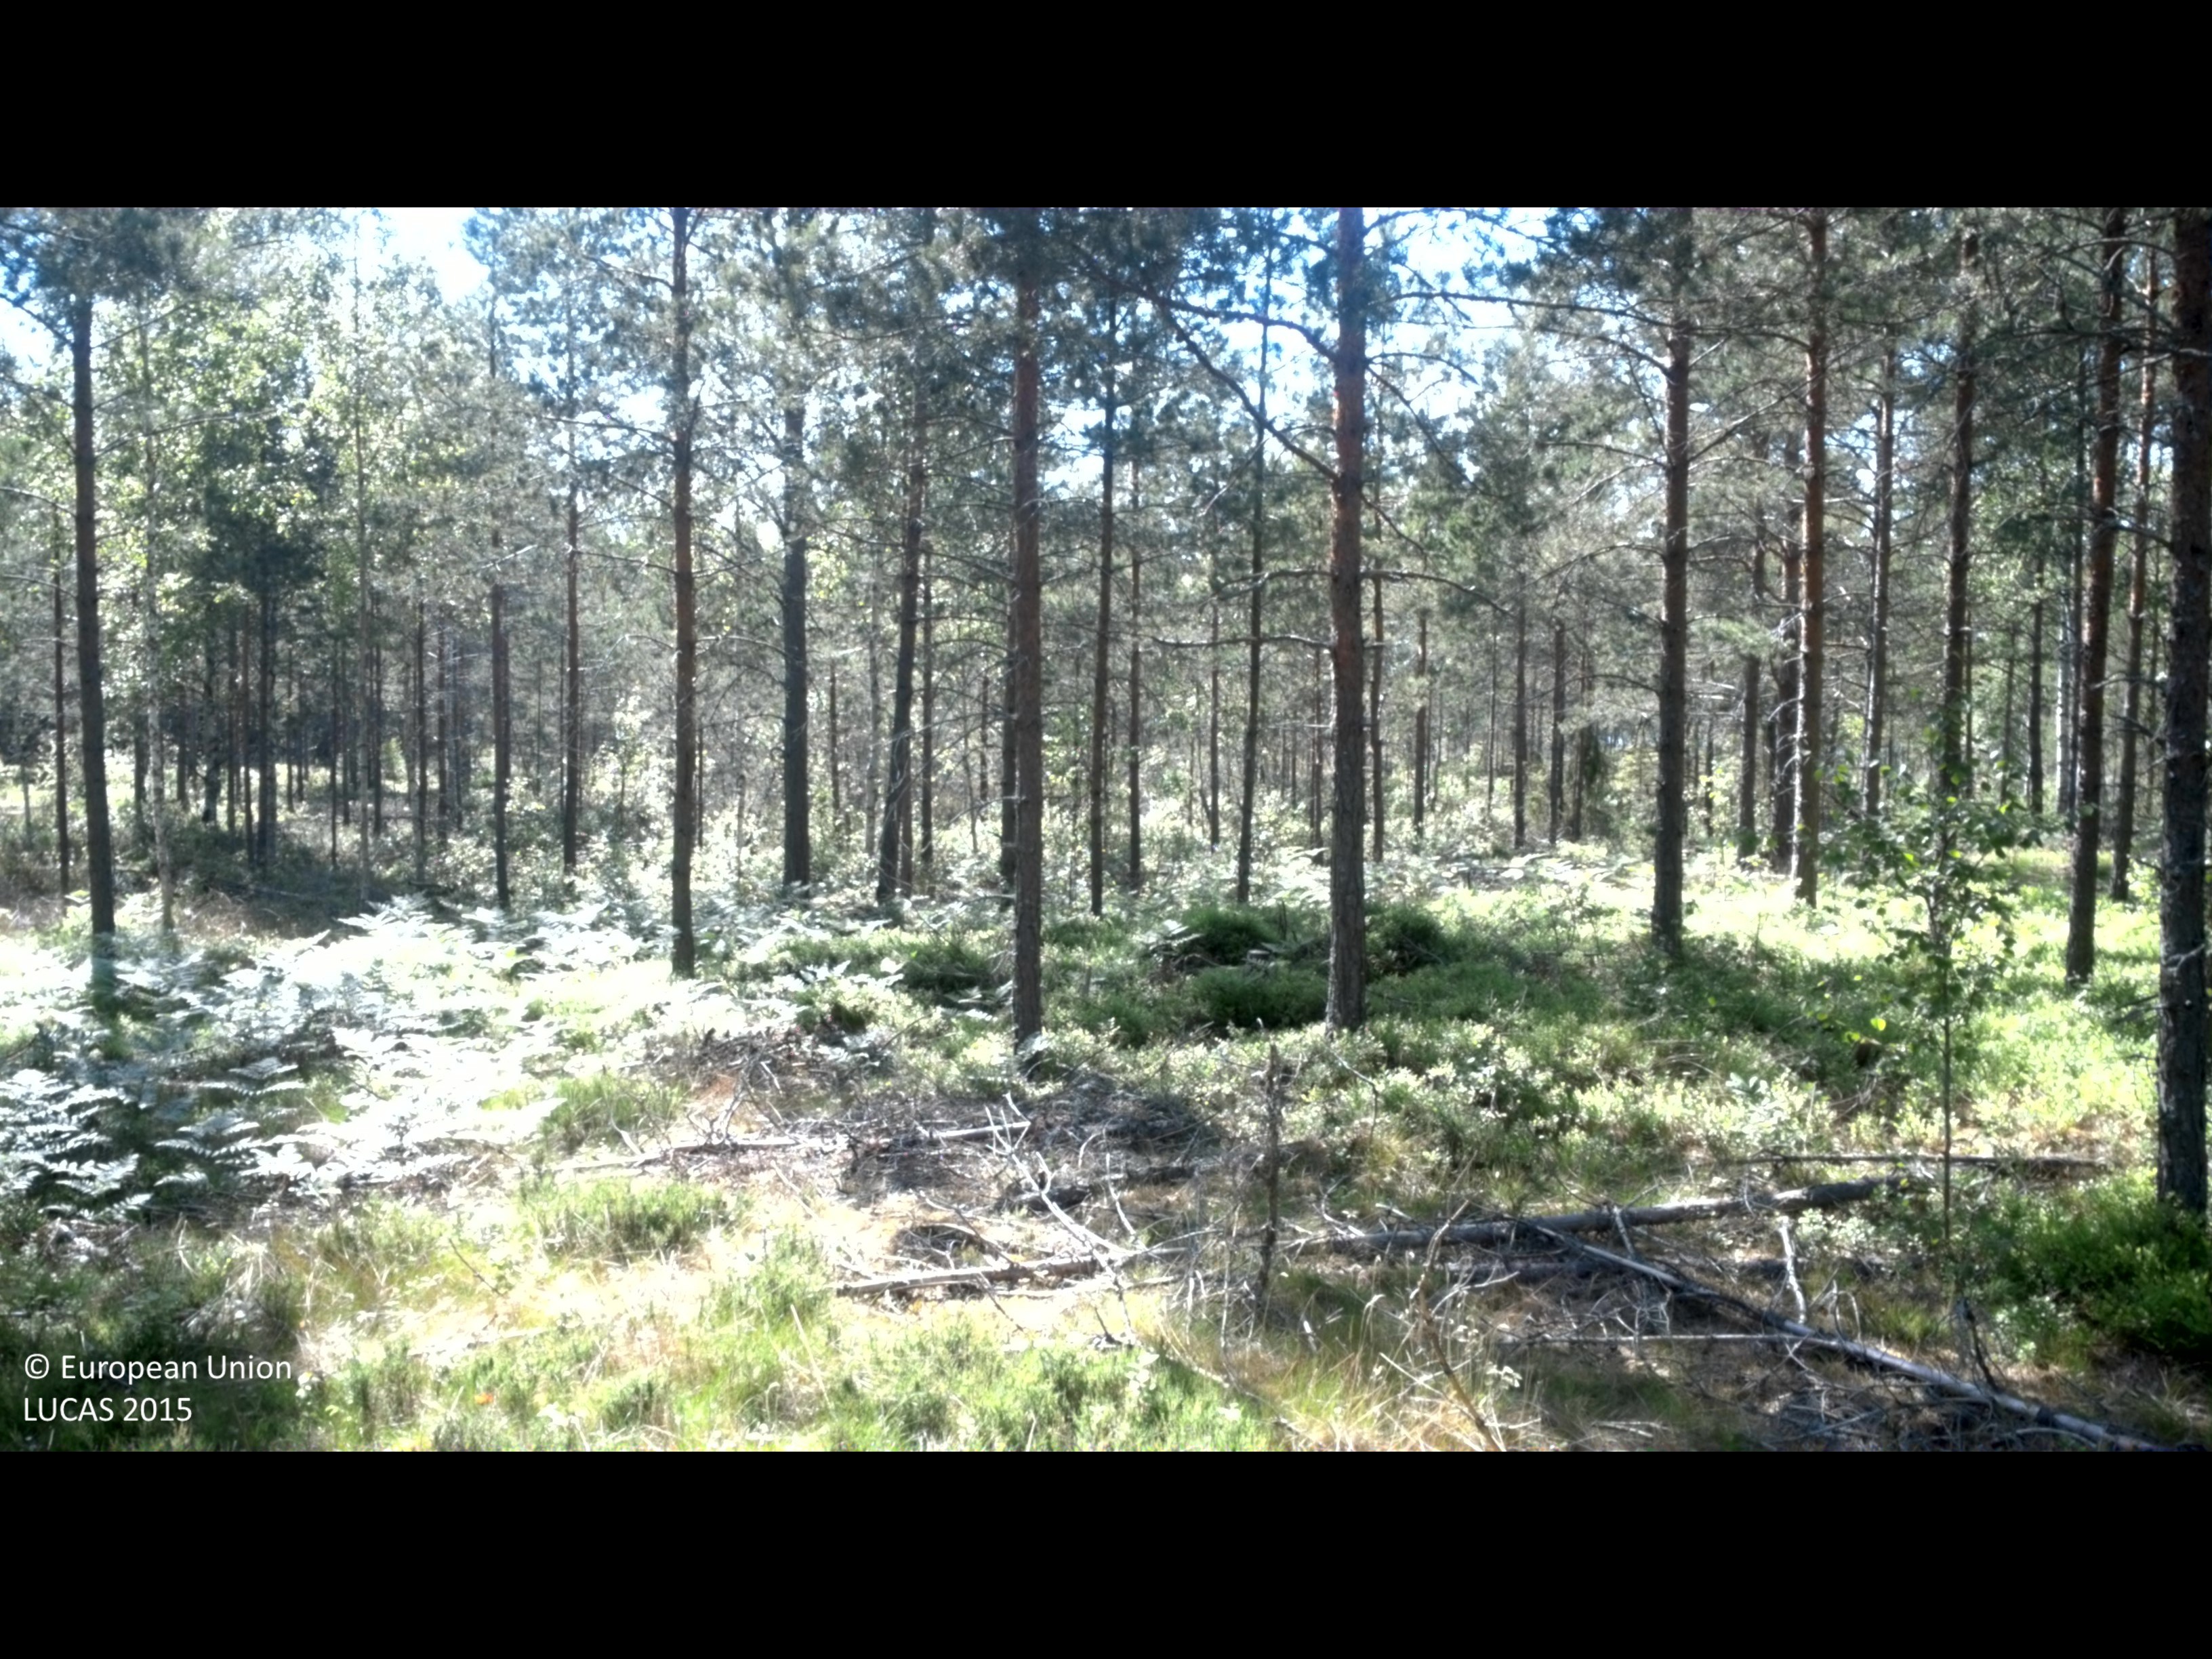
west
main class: Woodland
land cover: Pine dominated coniferous woodland
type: boreal forest
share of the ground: 50 - 75 %
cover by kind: coniferous forest trees 60 %, shrubs 20 %, herbaceous plants 10 %, broadleaved forest trees 5 %, lichens and mosses 5 %
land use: Forestry
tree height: > 5 m
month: June
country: SE
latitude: 57.6414
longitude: 16.6162
